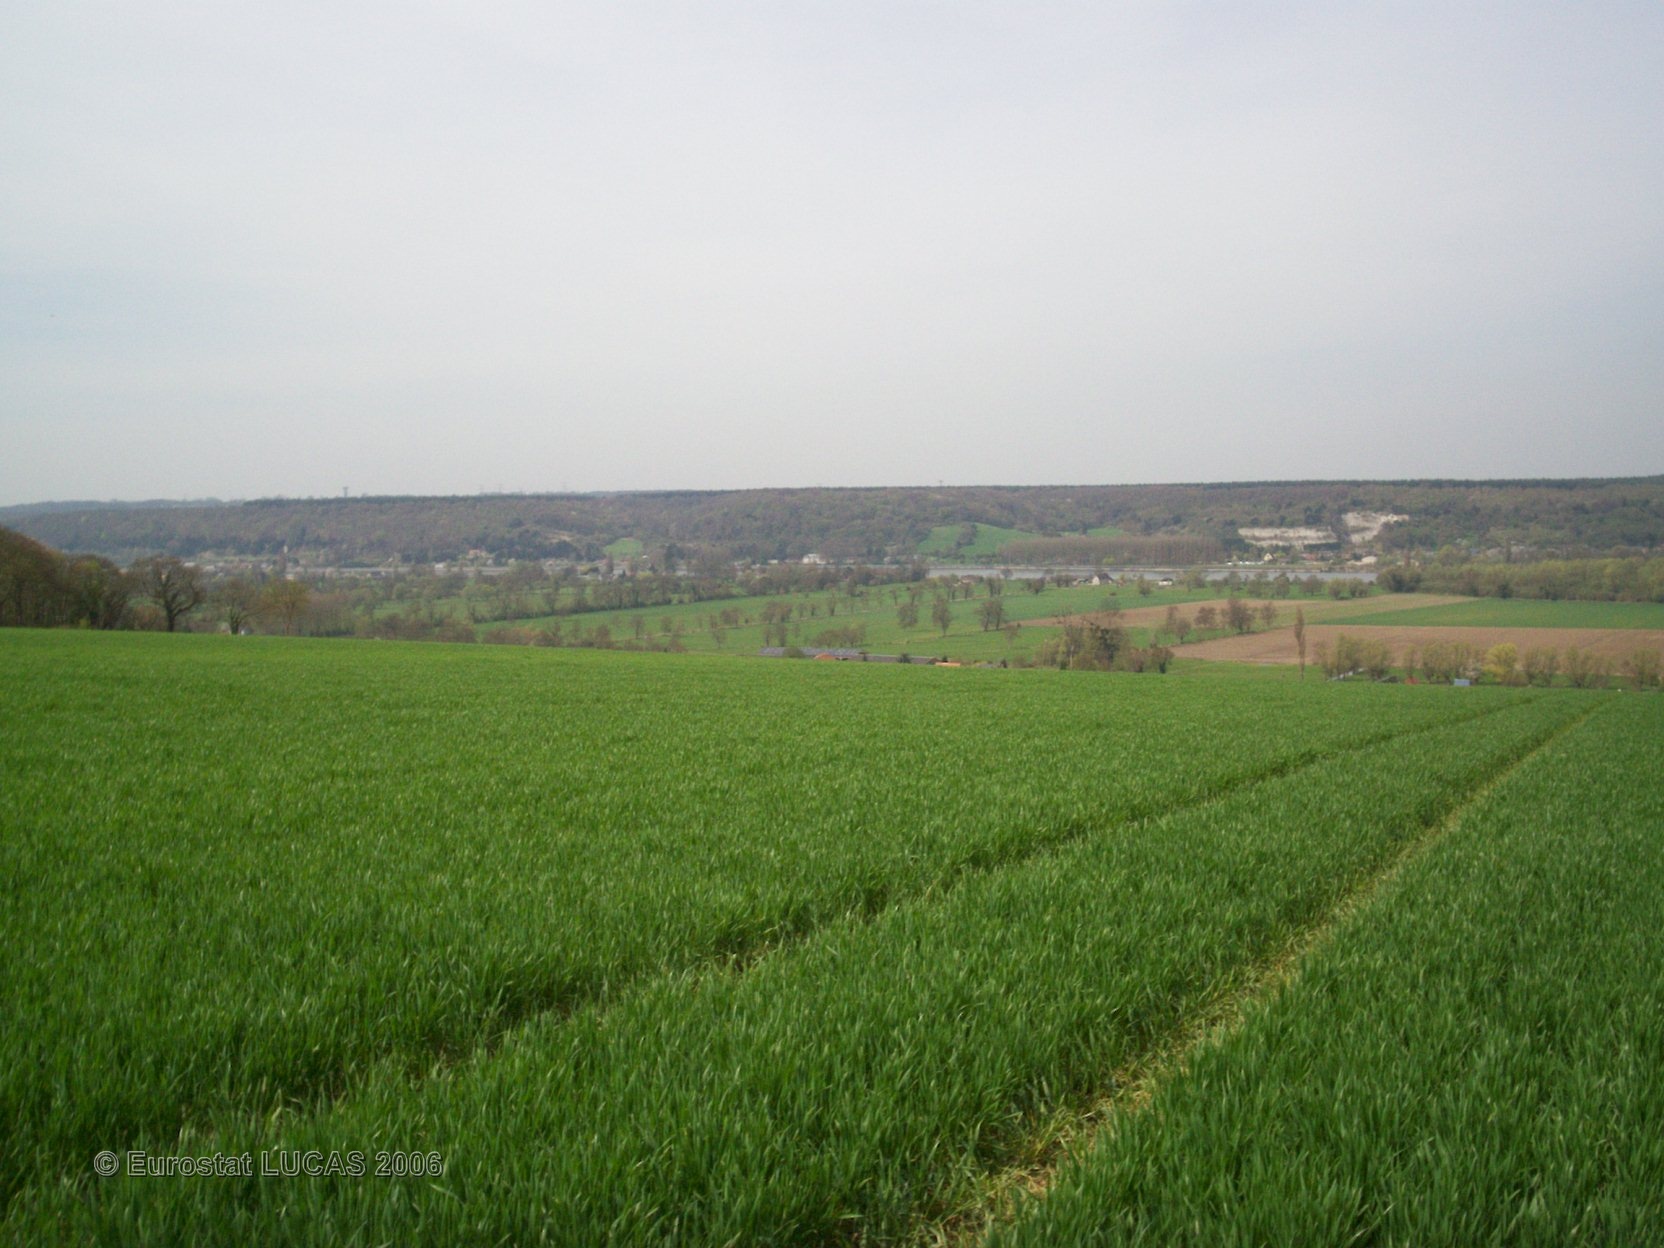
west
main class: Cropland
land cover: Common wheat
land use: Agriculture (excluding fallow land and kitchen gardens)
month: April
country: FR
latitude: 49.4075
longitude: 0.9502
